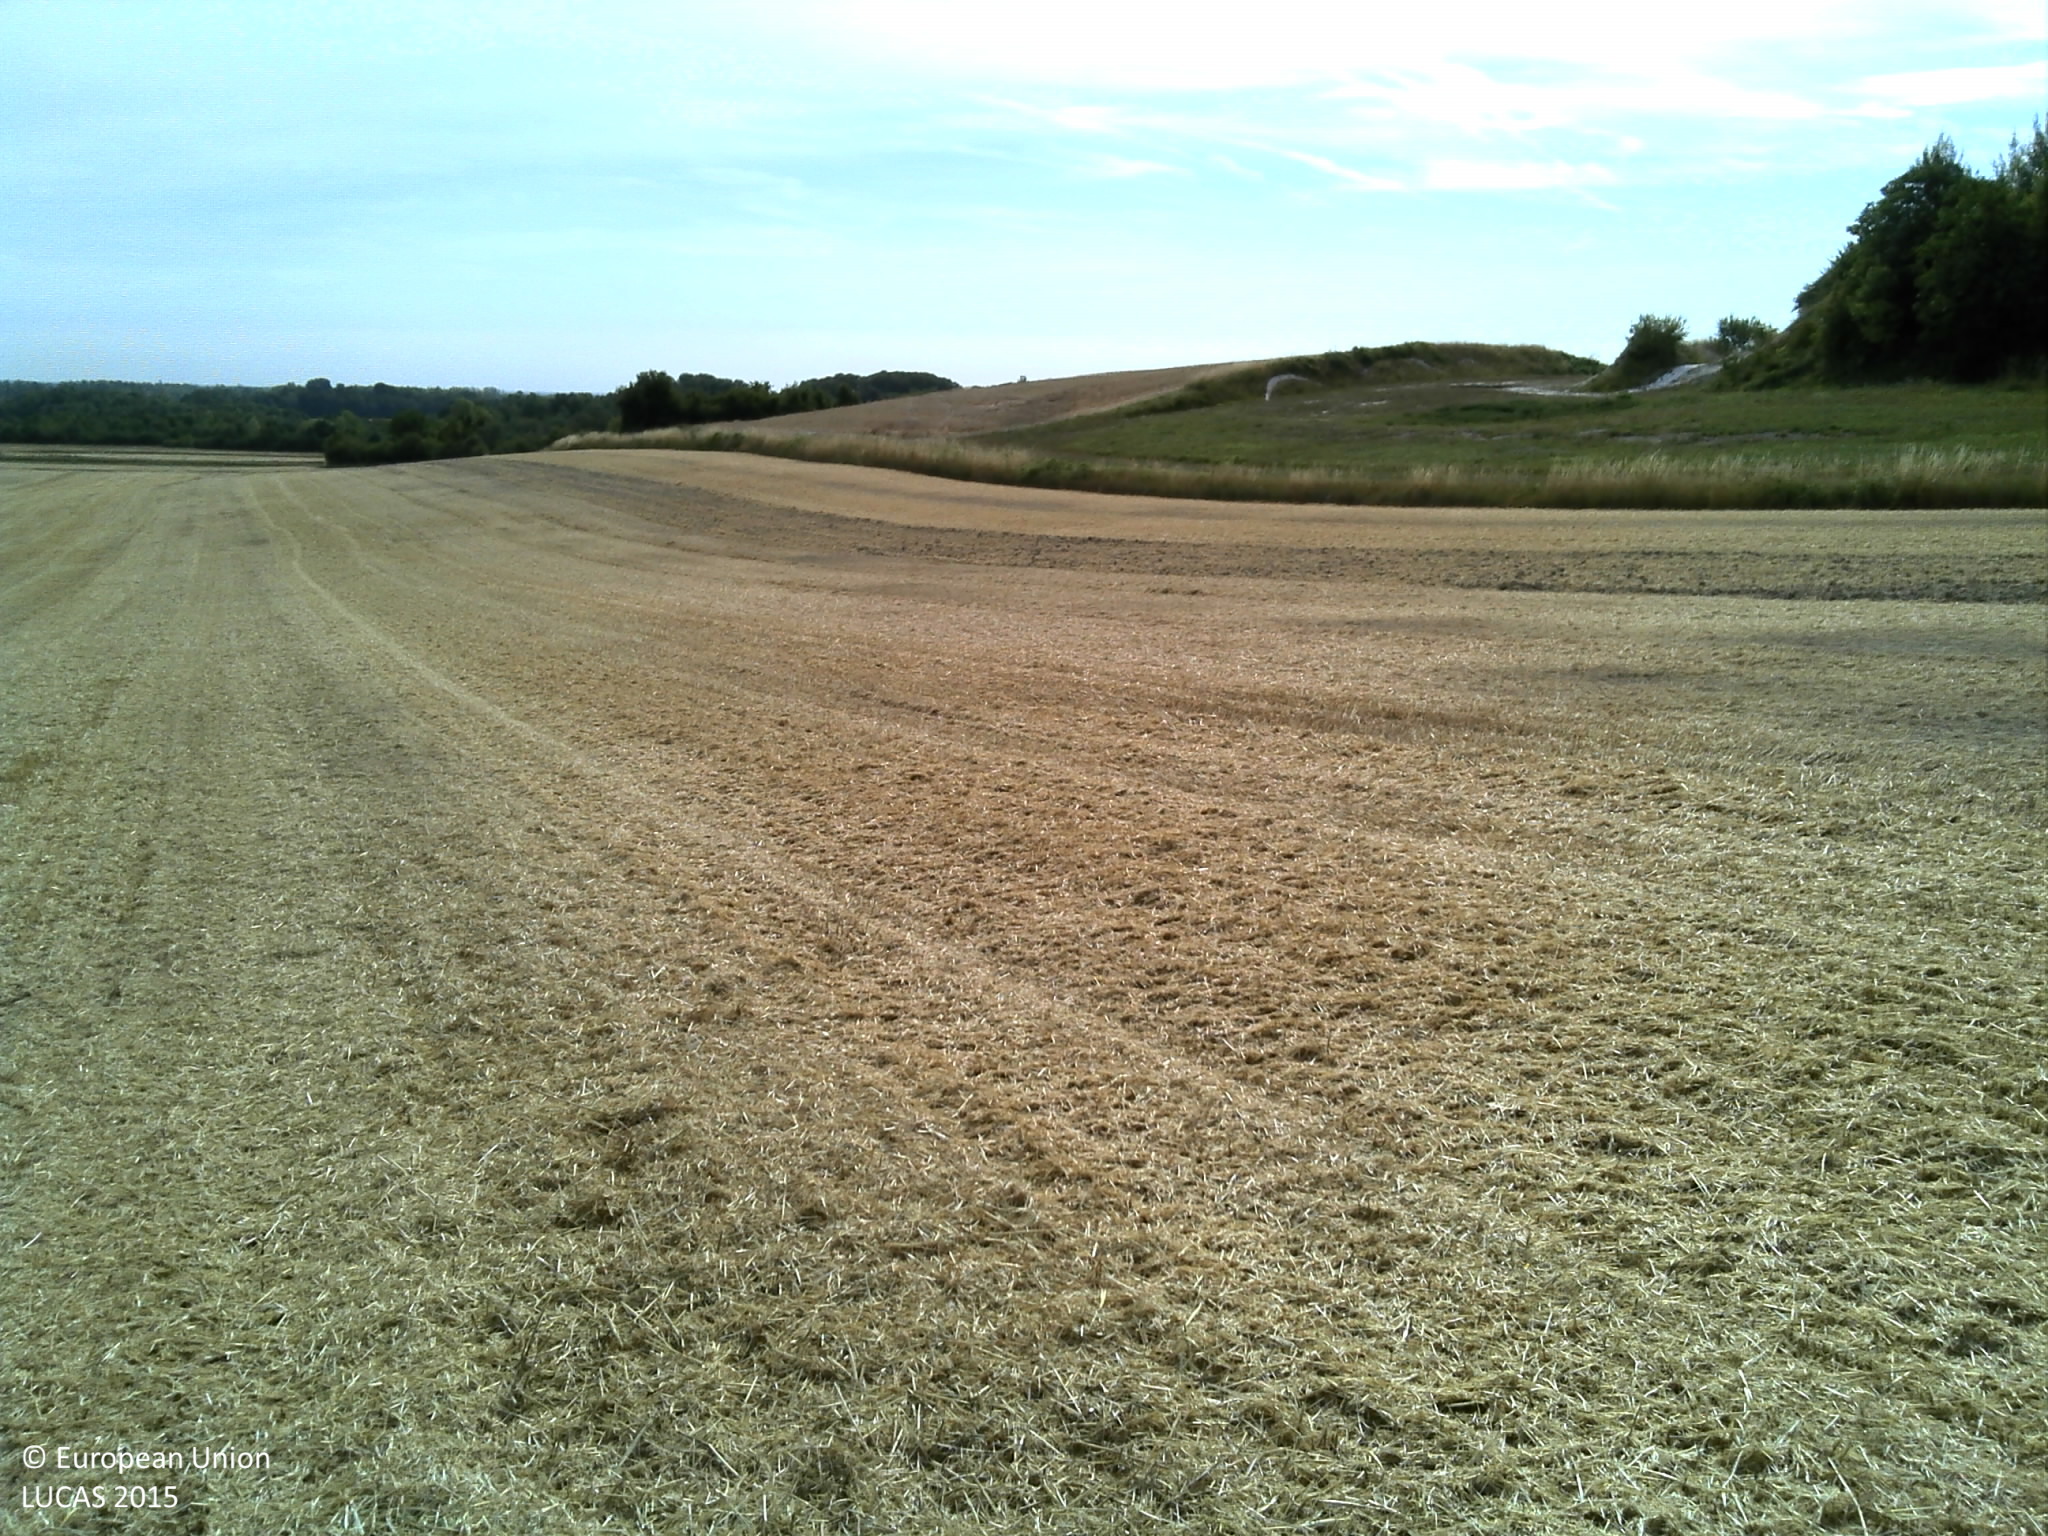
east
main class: Cropland
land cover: Common wheat
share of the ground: > 75 %
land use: Agriculture (excluding fallow land and kitchen gardens)
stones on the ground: < 10 %
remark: Harvested field
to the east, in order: Common wheat; Grass margins; Tracks; Grassland without tree/shrub cover; Tracks; Grass margins; Rape and turnip rape
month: July
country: FR
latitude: 48.6493
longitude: 4.5814
